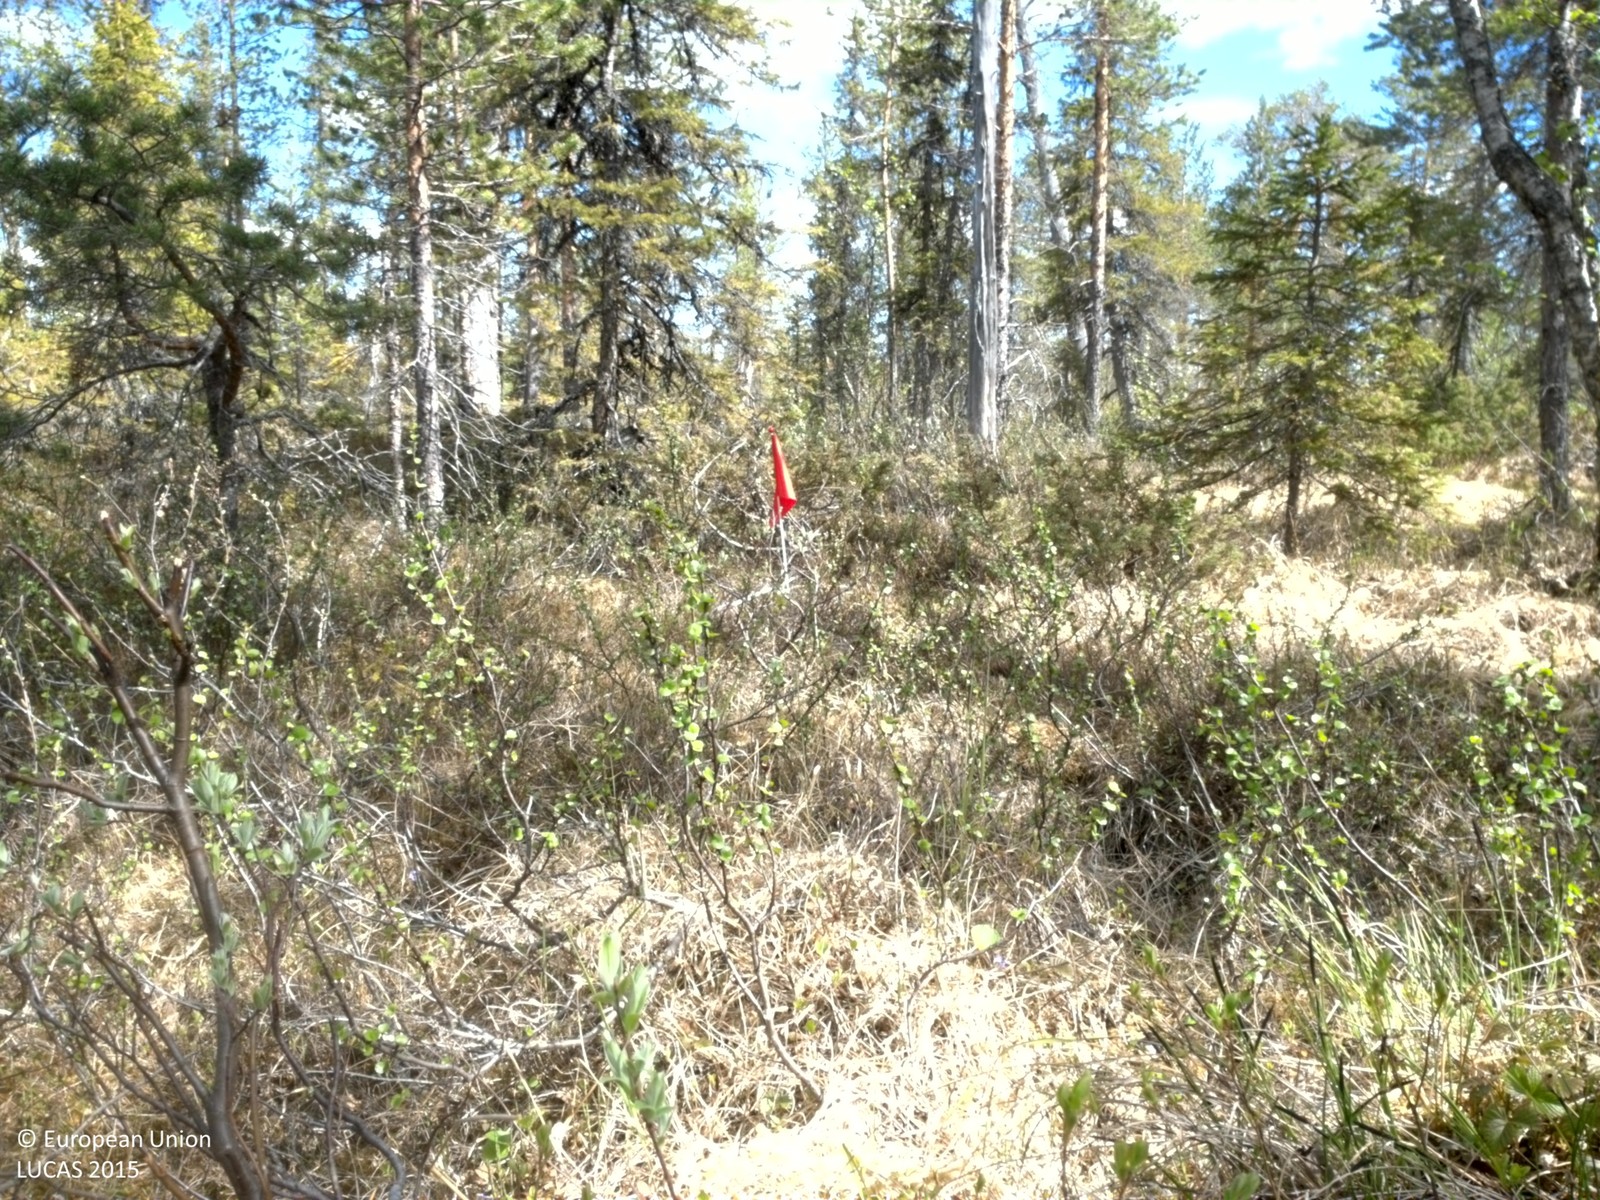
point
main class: Woodland
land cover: Pine dominated mixed woodland
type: boreal forest
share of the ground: 25 - 50 %
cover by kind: shrubs 55 %, coniferous forest trees 25 %, broadleaved forest trees 10 %, herbaceous plants 10 %
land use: Forestry
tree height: > 5 m
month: June
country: SE
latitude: 66.1028
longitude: 19.4469
